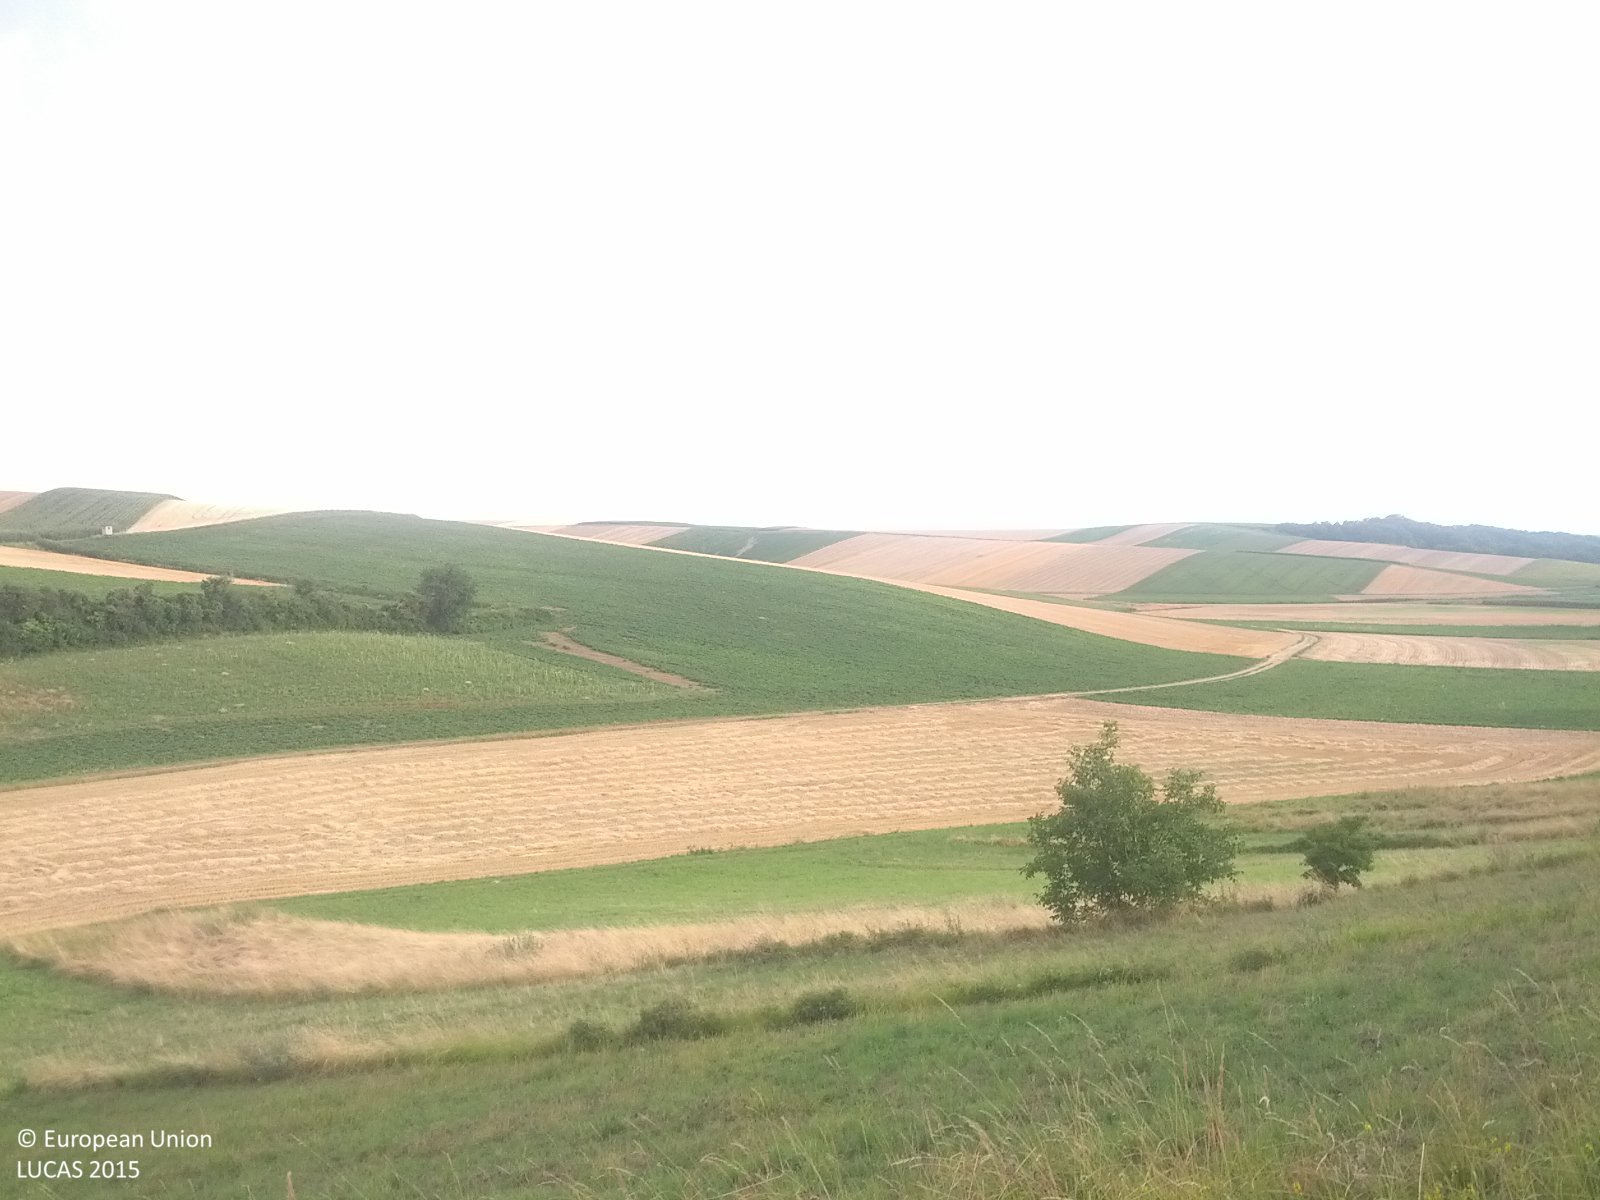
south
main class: Grassland
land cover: Grassland without tree/shrub cover
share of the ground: > 75 %
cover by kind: herbaceous plants 100 %
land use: Agriculture (excluding fallow land and kitchen gardens)
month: July
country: AT
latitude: 48.5141
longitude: 16.2730
